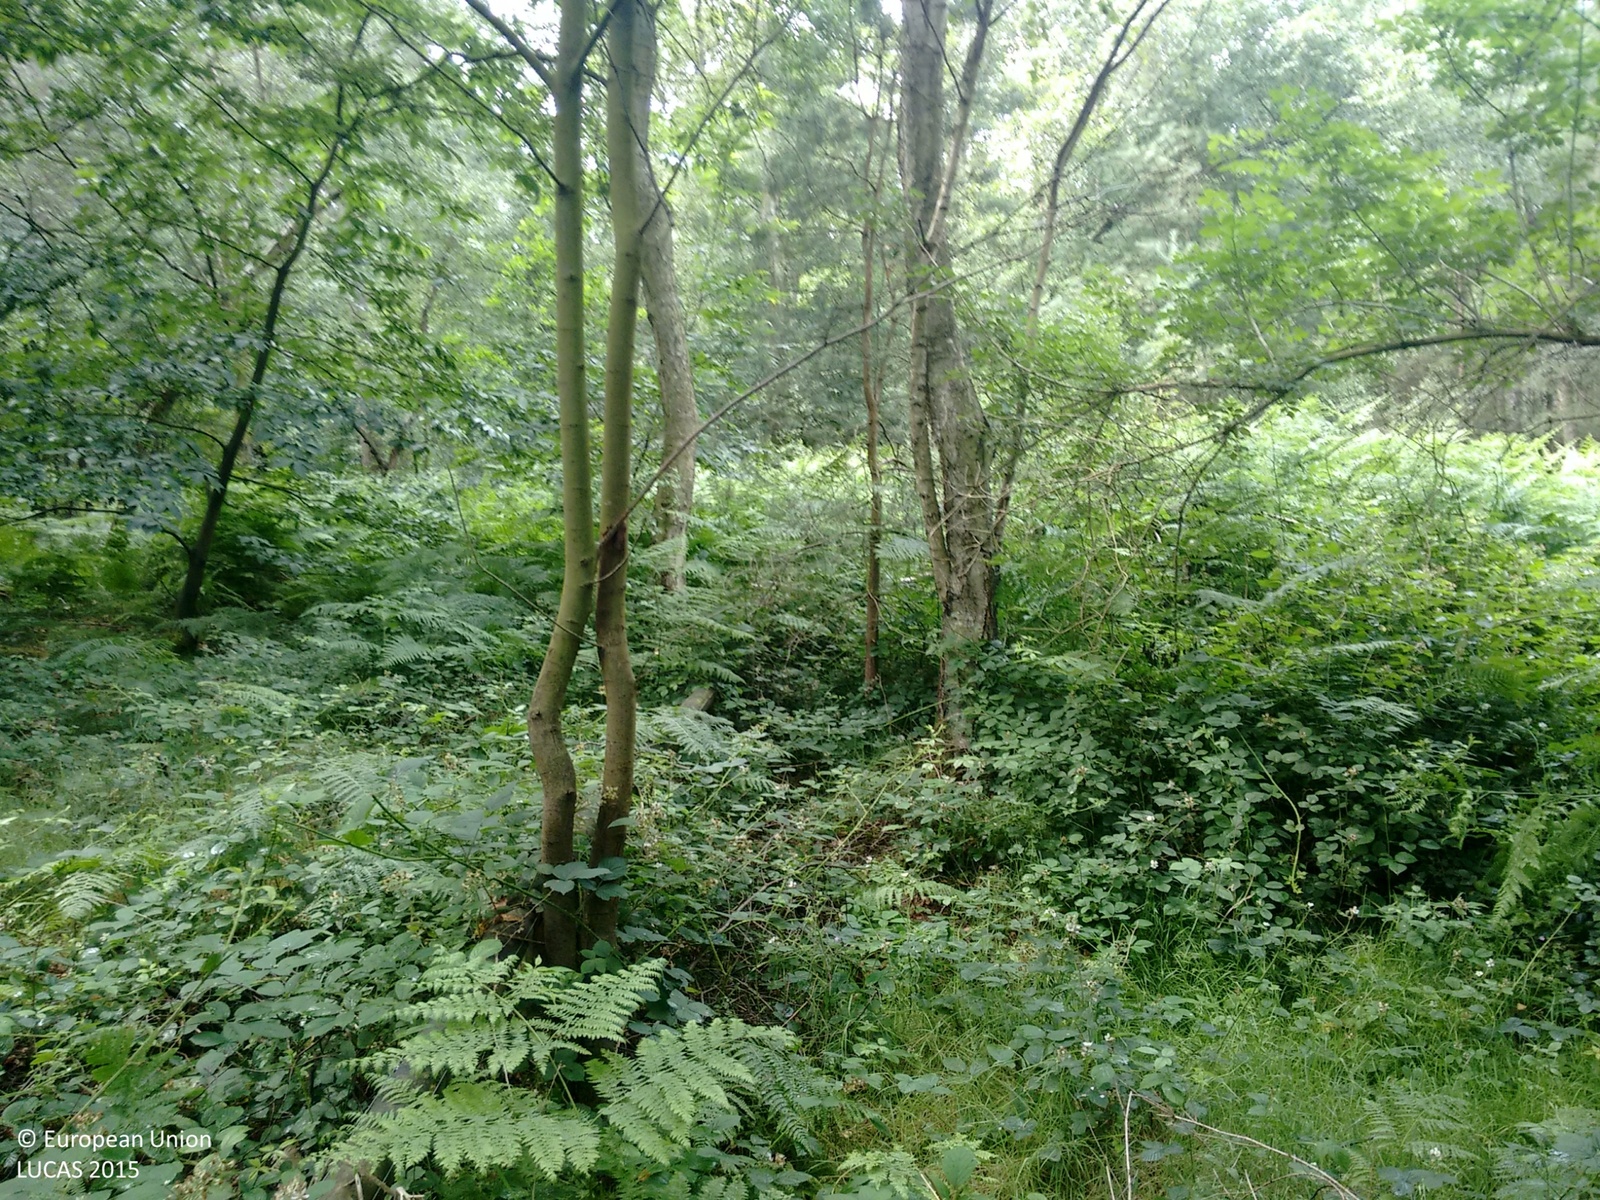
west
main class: Woodland
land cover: Spruce dominated coniferous woodland
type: exotic forest
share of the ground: > 75 %
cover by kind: coniferous forest trees 80 %, broadleaved forest trees 20 %
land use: Forestry
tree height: > 5 m
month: July
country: GB
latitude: 53.1446
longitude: -1.0935
